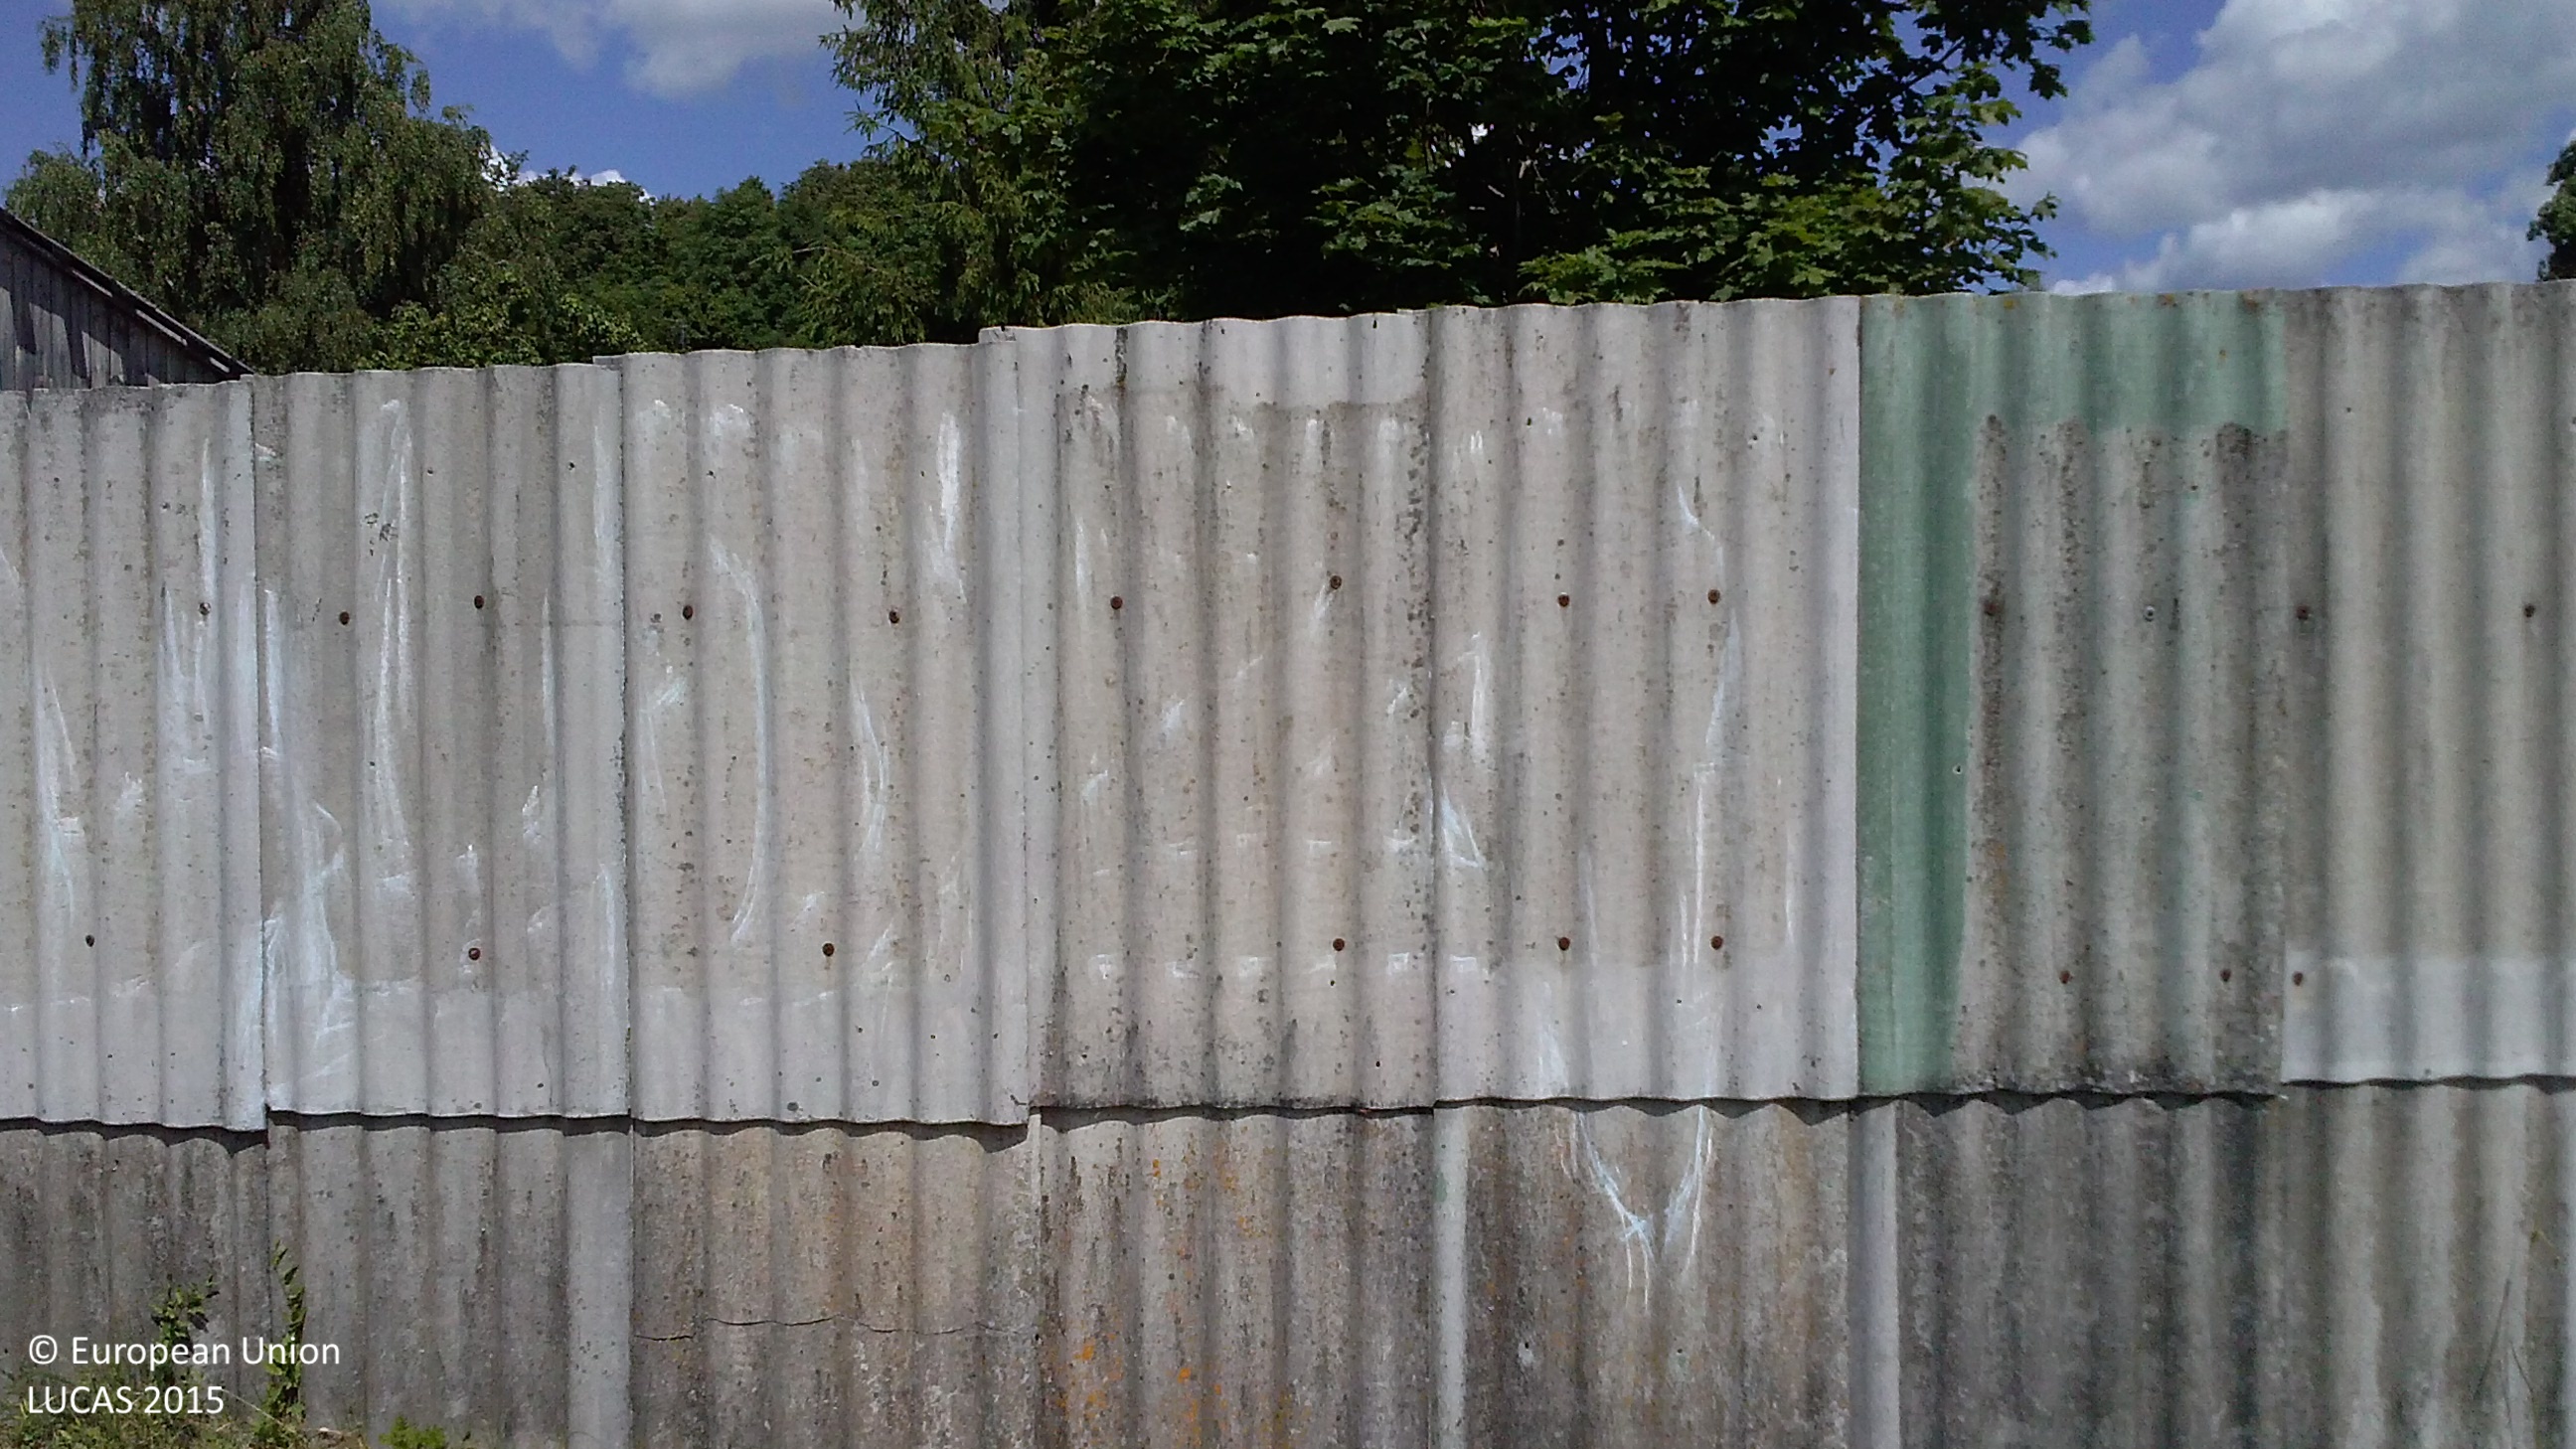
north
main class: Grassland
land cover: Grassland without tree/shrub cover
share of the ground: > 75 %
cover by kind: herbaceous plants 100 %
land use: Agriculture (excluding fallow land and kitchen gardens)
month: June
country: LV
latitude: 56.5438
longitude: 27.7360
